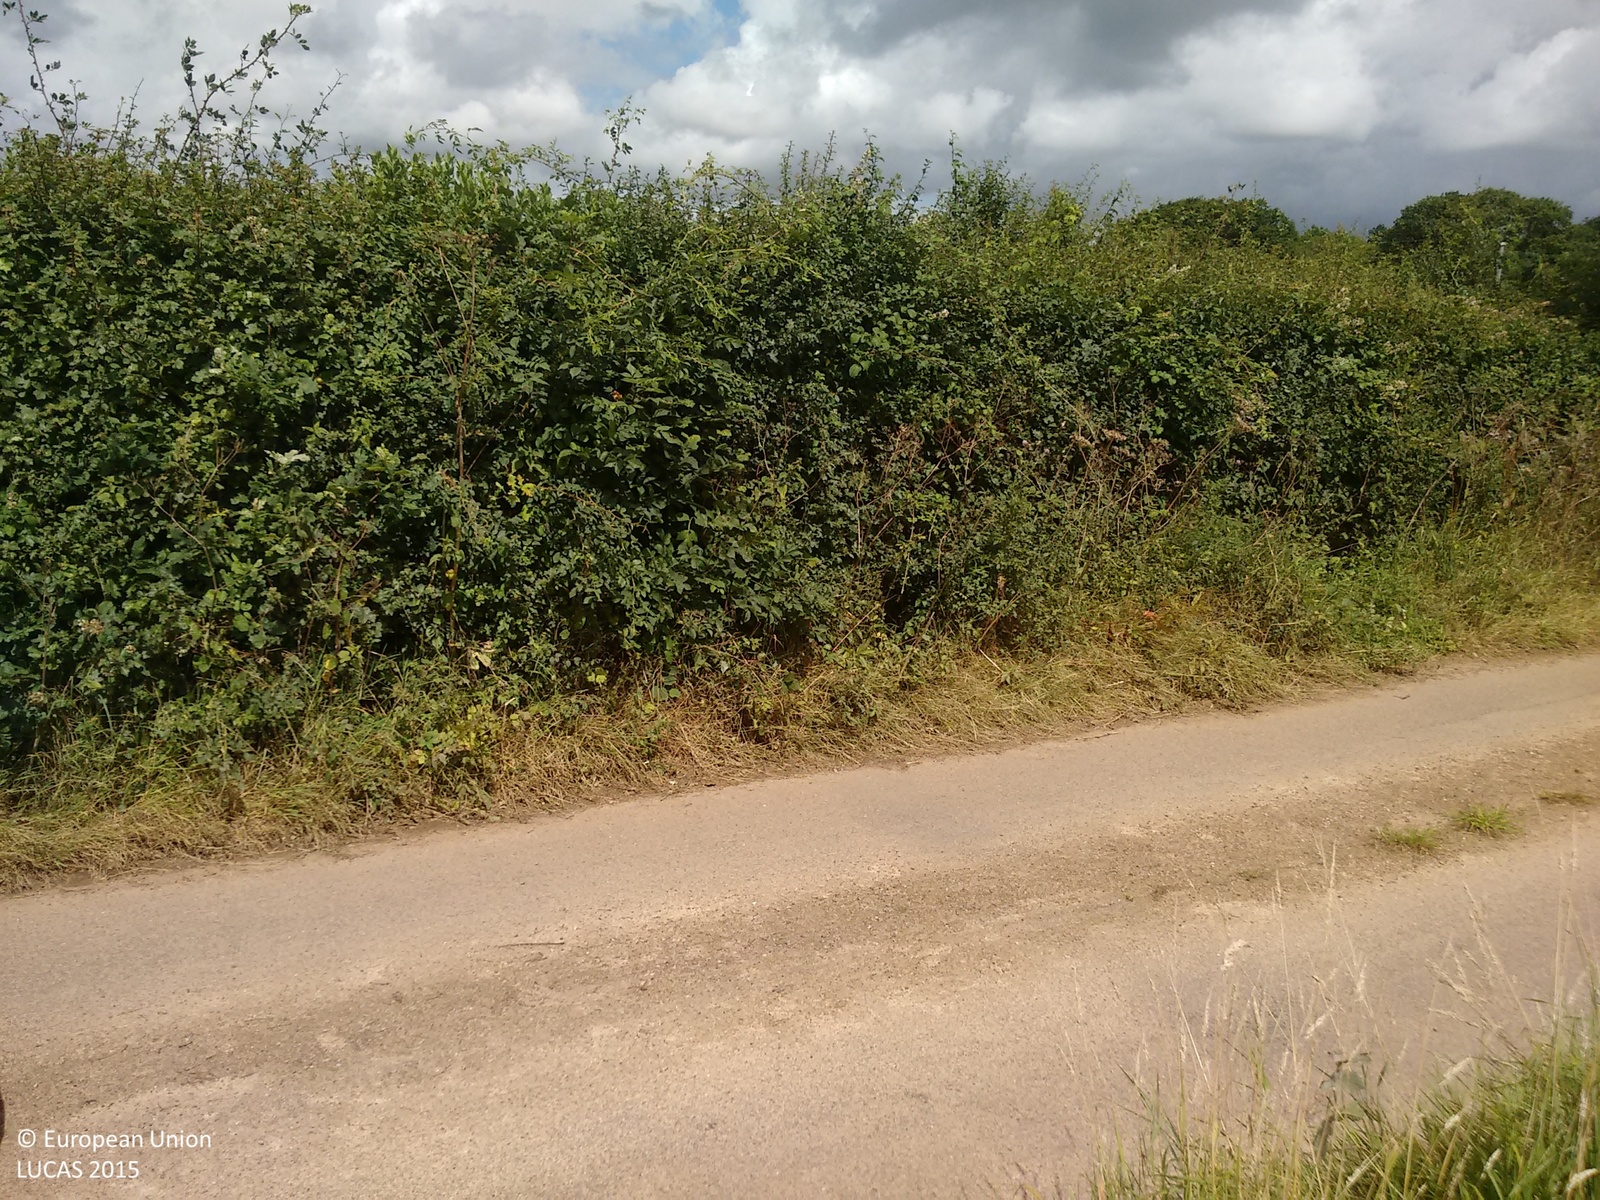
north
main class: Grassland
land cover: Grassland without tree/shrub cover
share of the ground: > 75 %
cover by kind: herbaceous plants 100 %
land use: Agriculture (excluding fallow land and kitchen gardens)
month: July
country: GB
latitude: 50.6656
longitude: -3.3951
